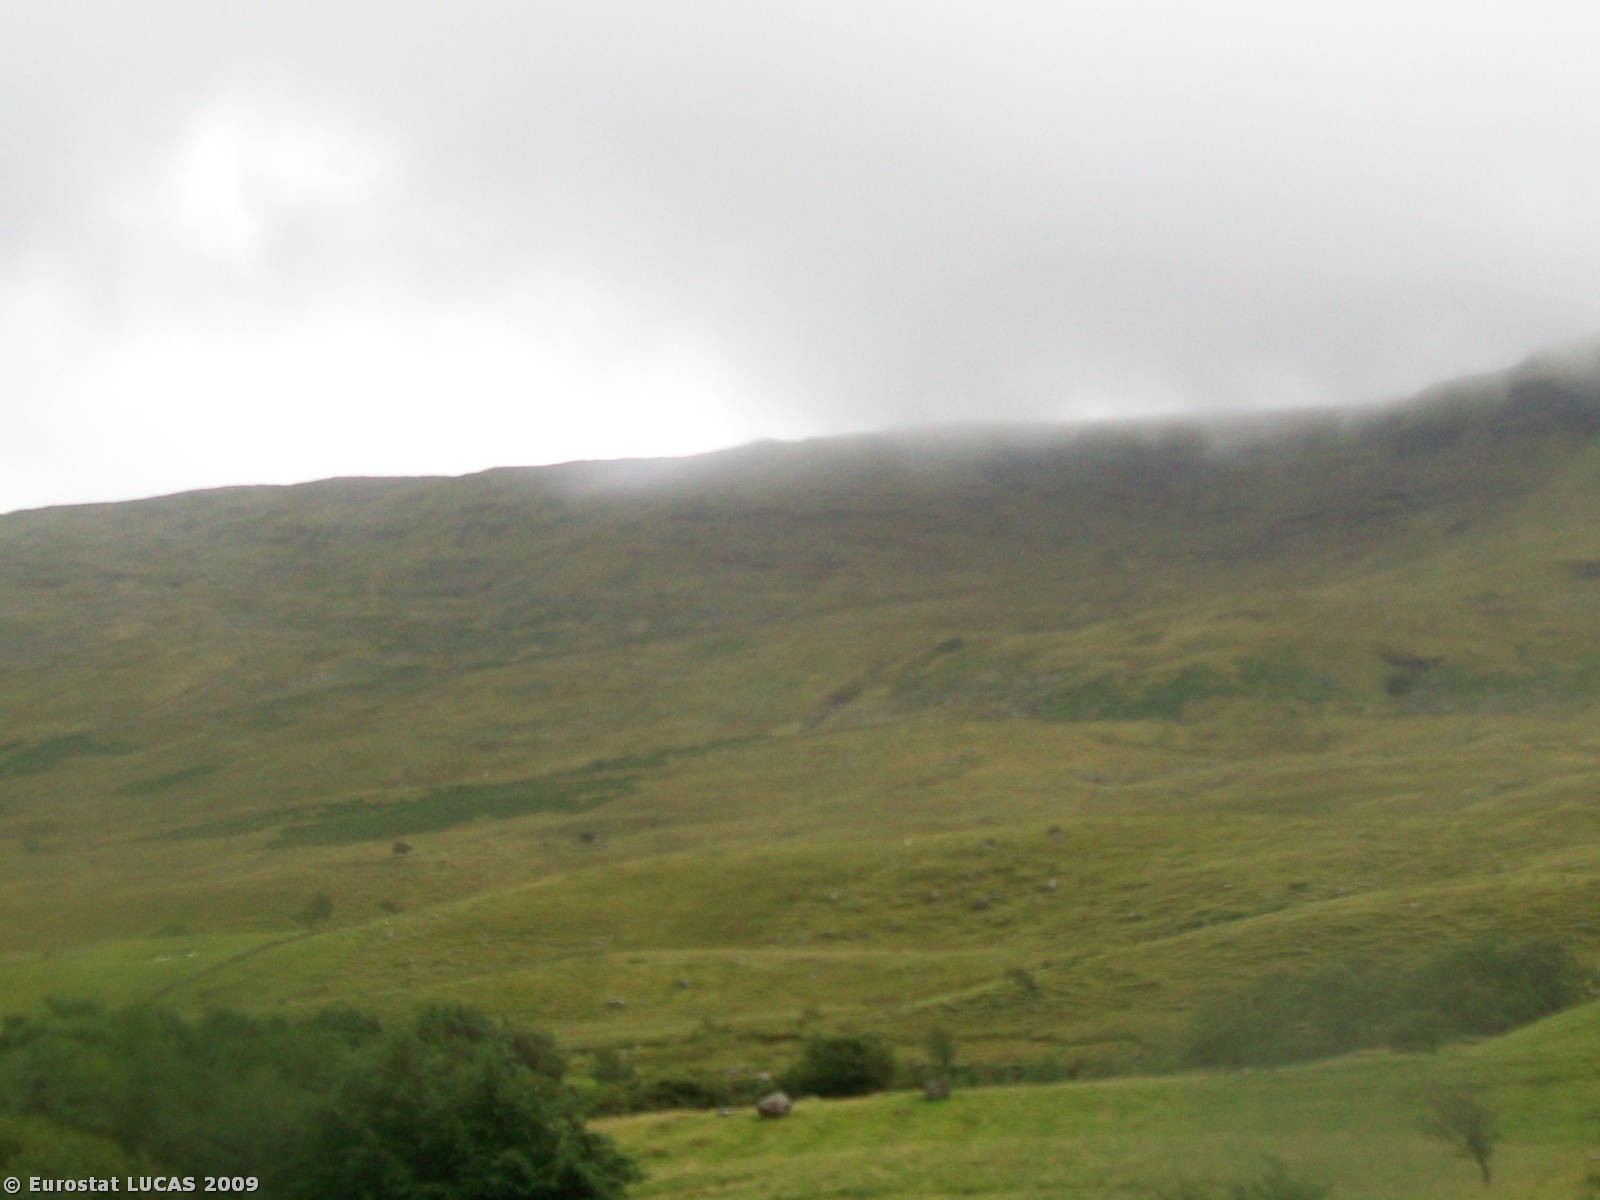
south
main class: Grassland
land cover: Grassland without tree/shrub cover
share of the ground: > 75 %
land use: Agriculture (excluding fallow land and kitchen gardens)
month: July
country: IE
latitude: 53.5433
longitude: -9.5666
